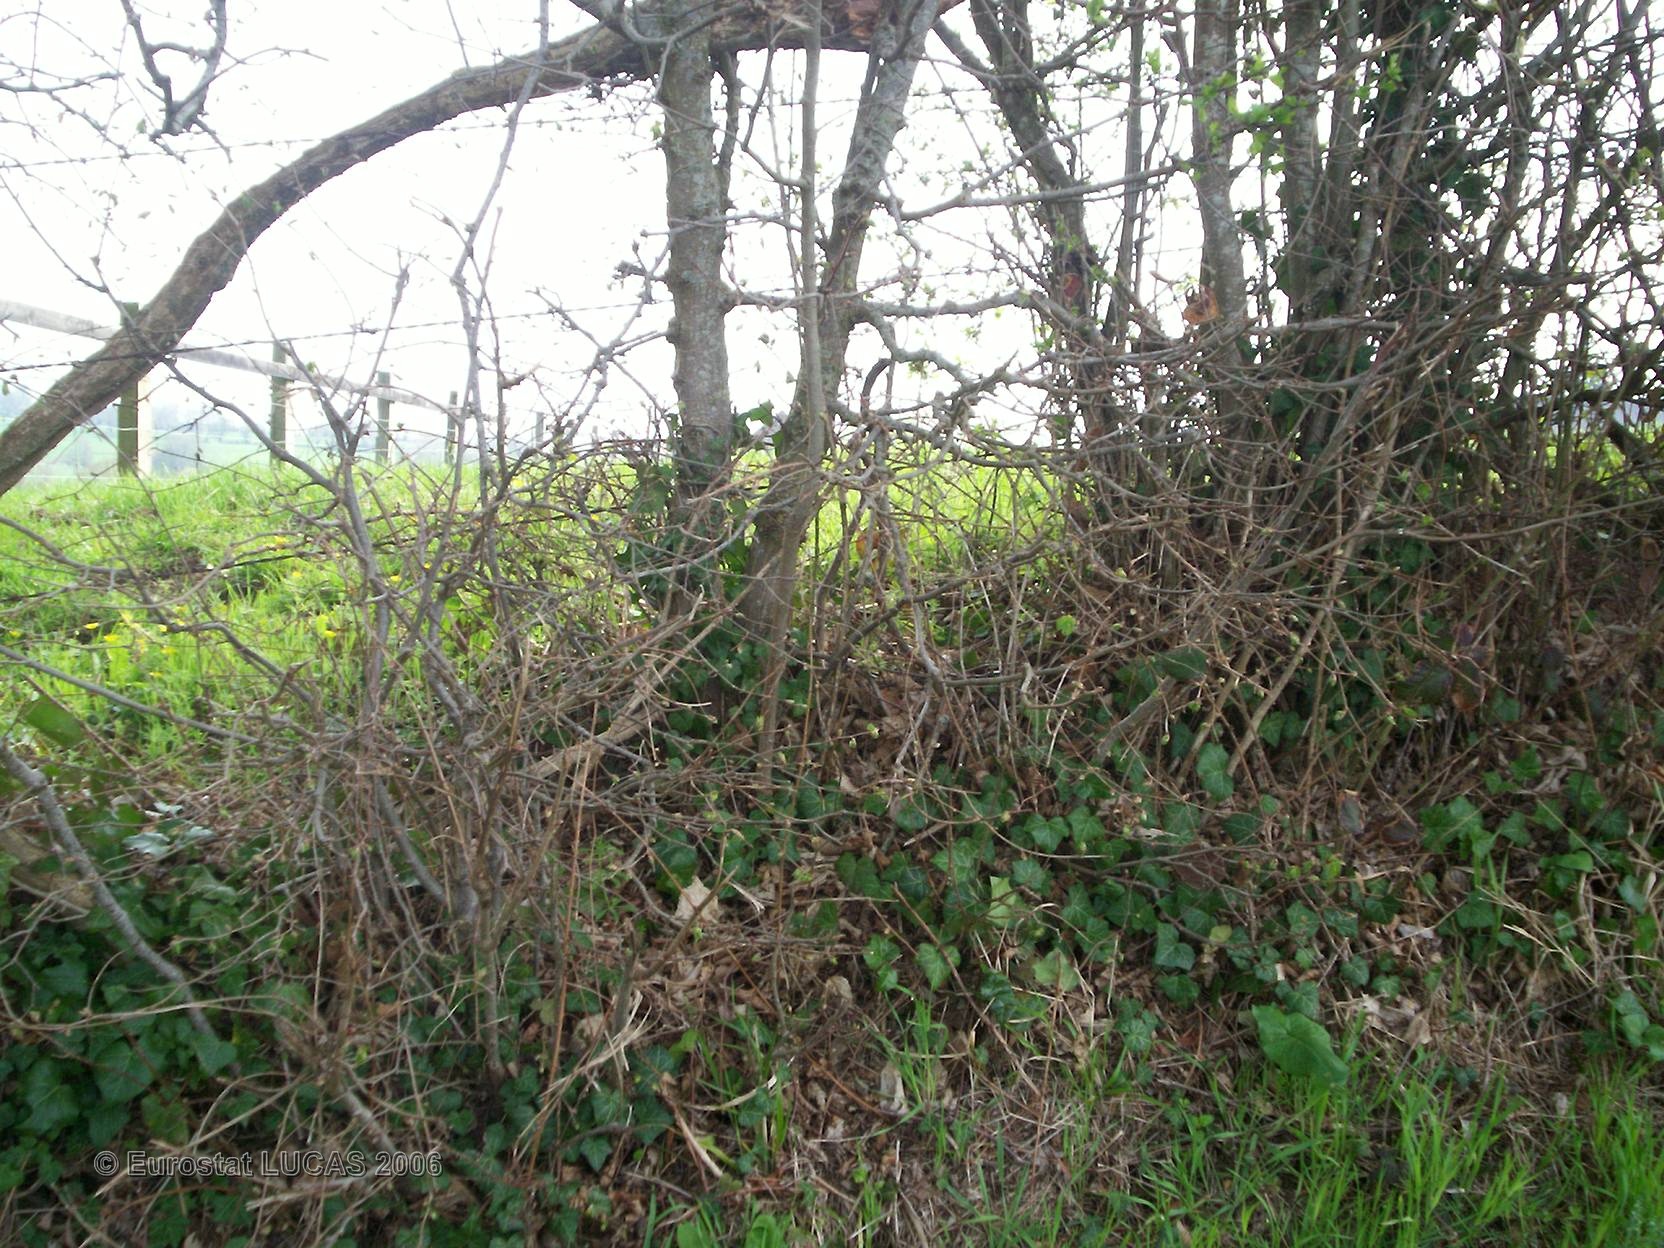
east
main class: Grassland
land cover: Grassland without tree/shrub cover
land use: Agriculture (excluding fallow land and kitchen gardens)
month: April
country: FR
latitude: 48.7506
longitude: 0.2476
